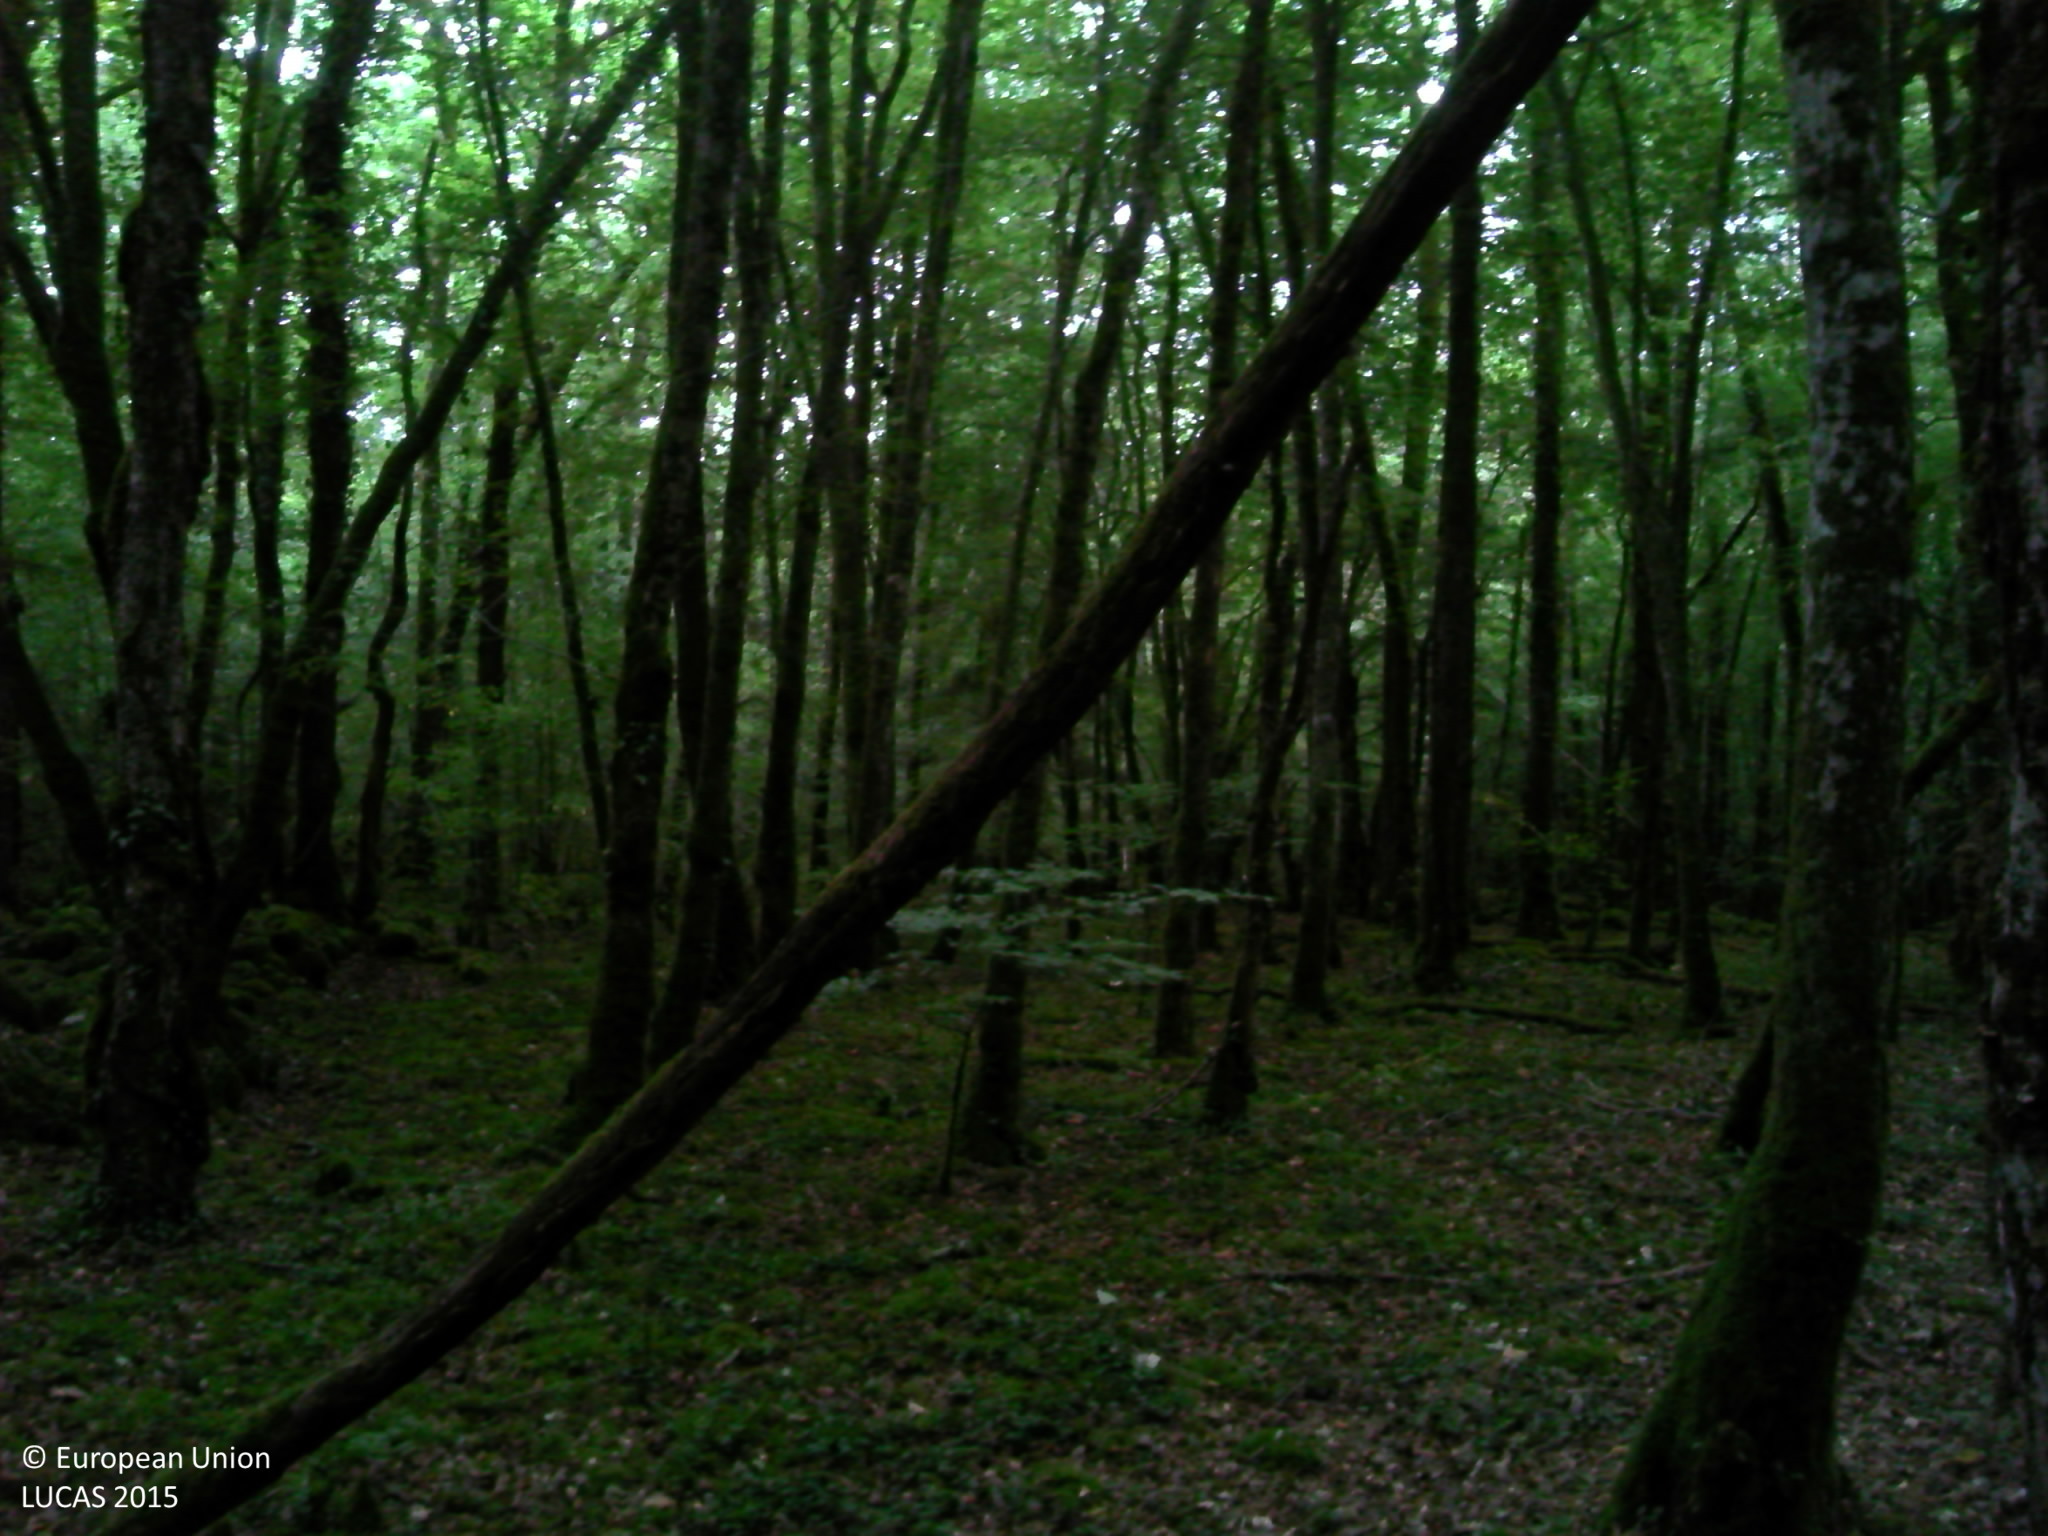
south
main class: Woodland
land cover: Pine dominated mixed woodland
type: hemiboreal forest and nemoral coniferous forest and mixed broadleaved-coniferous forest
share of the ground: > 75 %
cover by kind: coniferous forest trees 45 %, broadleaved forest trees 45 %, herbaceous plants 5 %, lichens and mosses 5 %
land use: Forestry
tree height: > 5 m
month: August
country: FR
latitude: 47.7510
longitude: 4.6501
